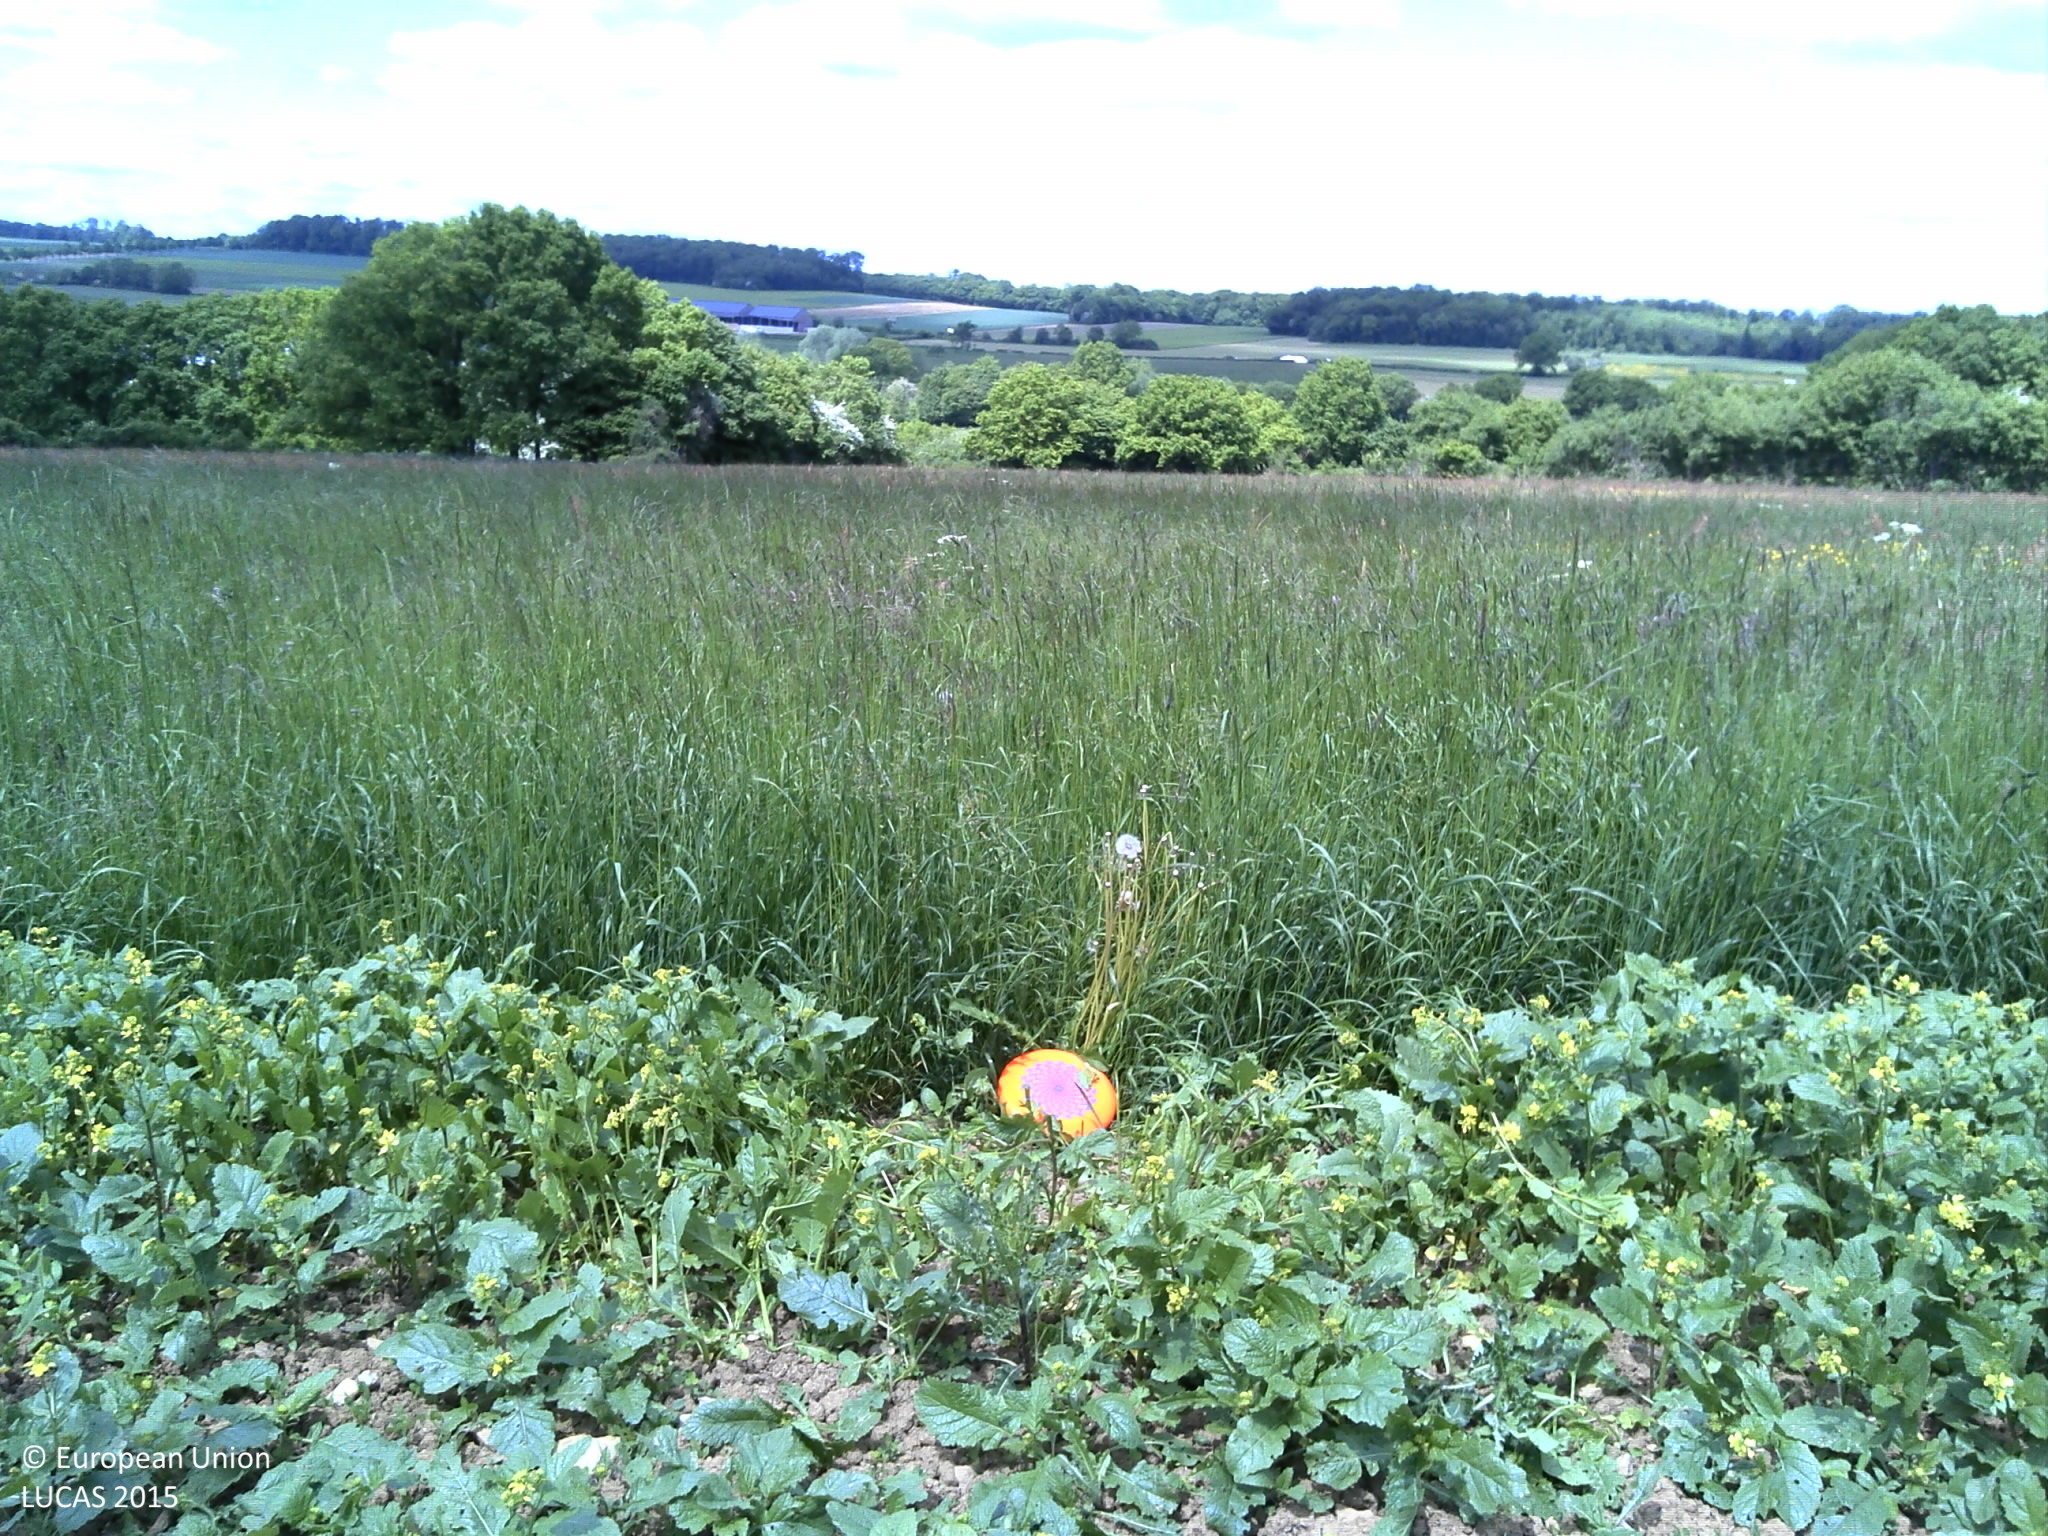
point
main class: Cropland
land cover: Temporary grasslands
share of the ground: > 75 %
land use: Agriculture (excluding fallow land and kitchen gardens)
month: May
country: LU
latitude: 49.7186
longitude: 6.0185
